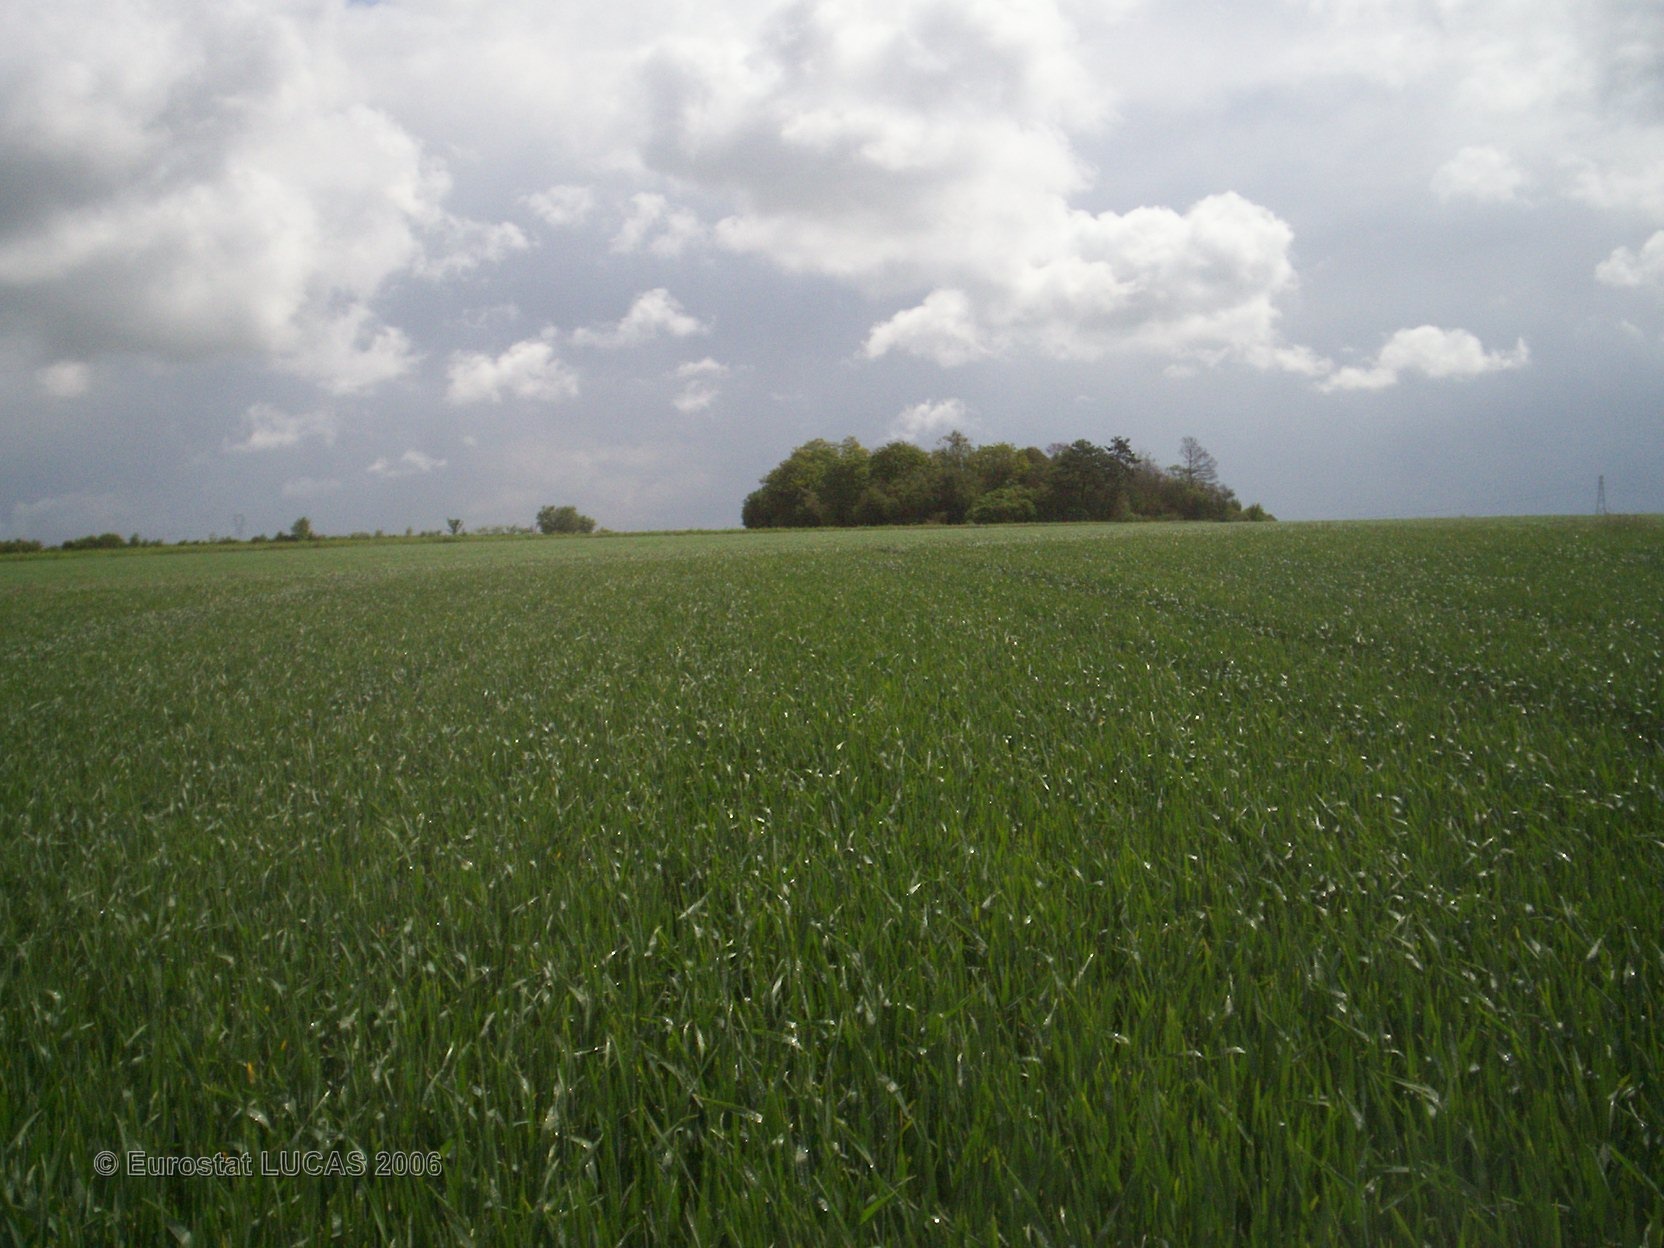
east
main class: Cropland
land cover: Common wheat
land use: Agriculture (excluding fallow land and kitchen gardens)
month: May
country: FR
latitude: 49.3791
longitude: 4.3900
